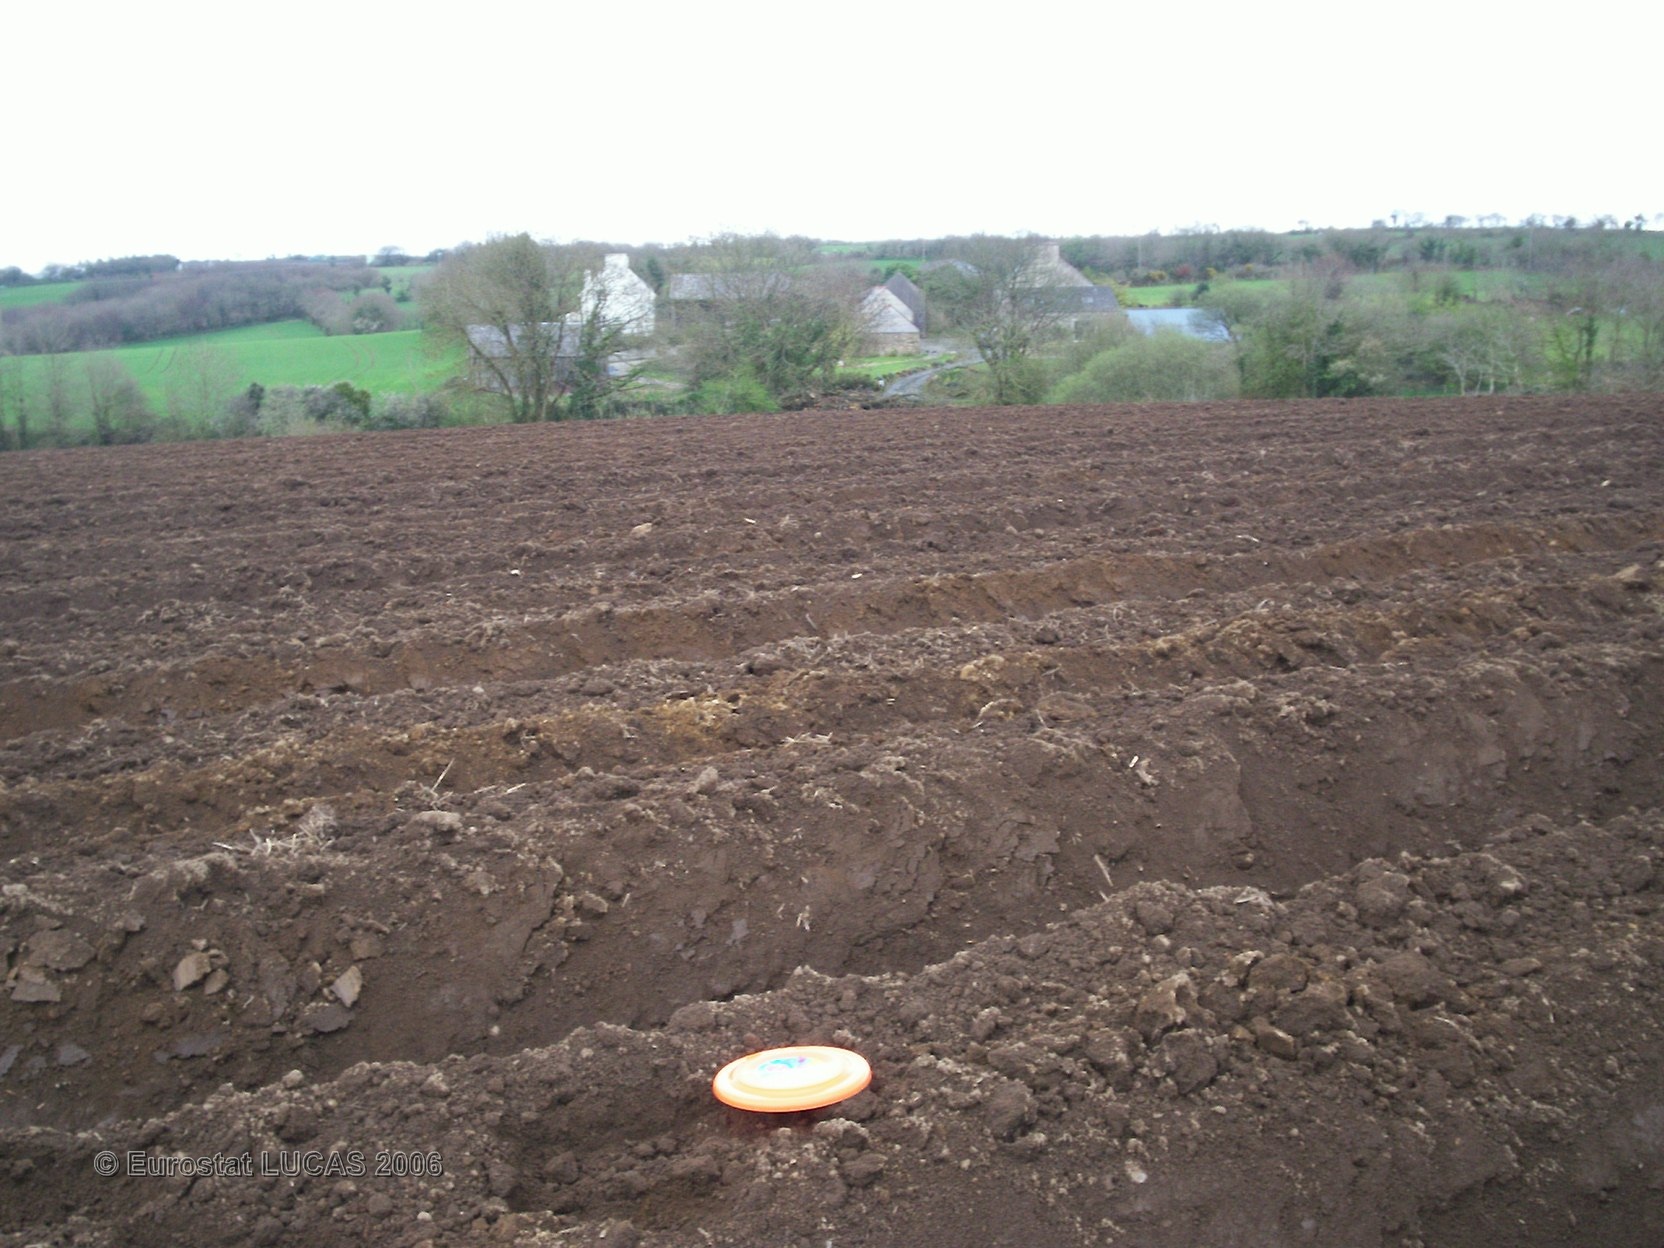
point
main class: Cropland
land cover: Potatoes
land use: Agriculture (excluding fallow land and kitchen gardens)
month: June
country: FR
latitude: 48.4211
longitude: -3.9928
